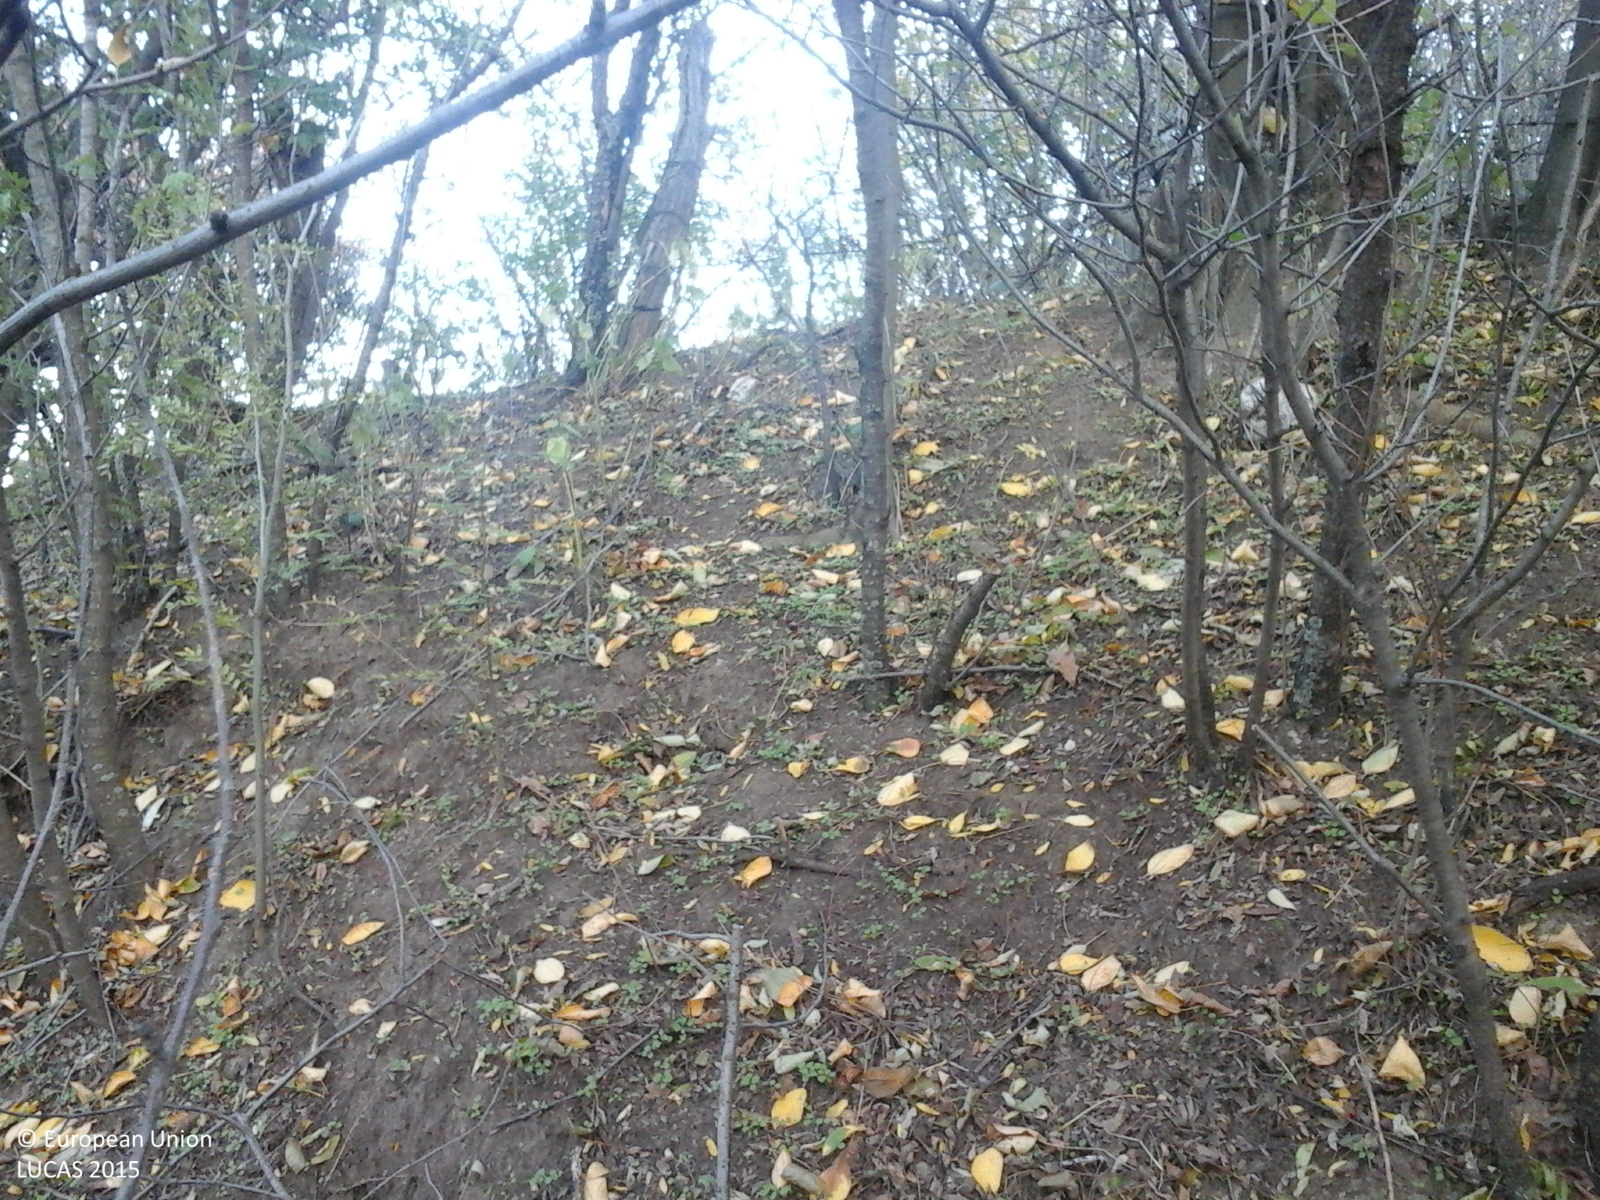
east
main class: Woodland
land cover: Broadleaved woodland
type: exotic forest
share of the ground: > 75 %
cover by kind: broadleaved forest trees 100 %
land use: Forestry
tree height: > 5 m
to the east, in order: Broadleaved woodland; Fences; Broadleaved woodland; Grassland without tree/shrub cover; Spontaneously vegetated surfaces; Fences; Other fresh vegetables; Fences; Grassland with sparse tree/shrub cover; Rivers and streams; Broadleaved woodland; Rivers and streams; Broadleaved woodland; Grassland with sparse tree/shrub cover
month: October
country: RO
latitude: 45.4723
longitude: 27.0109
